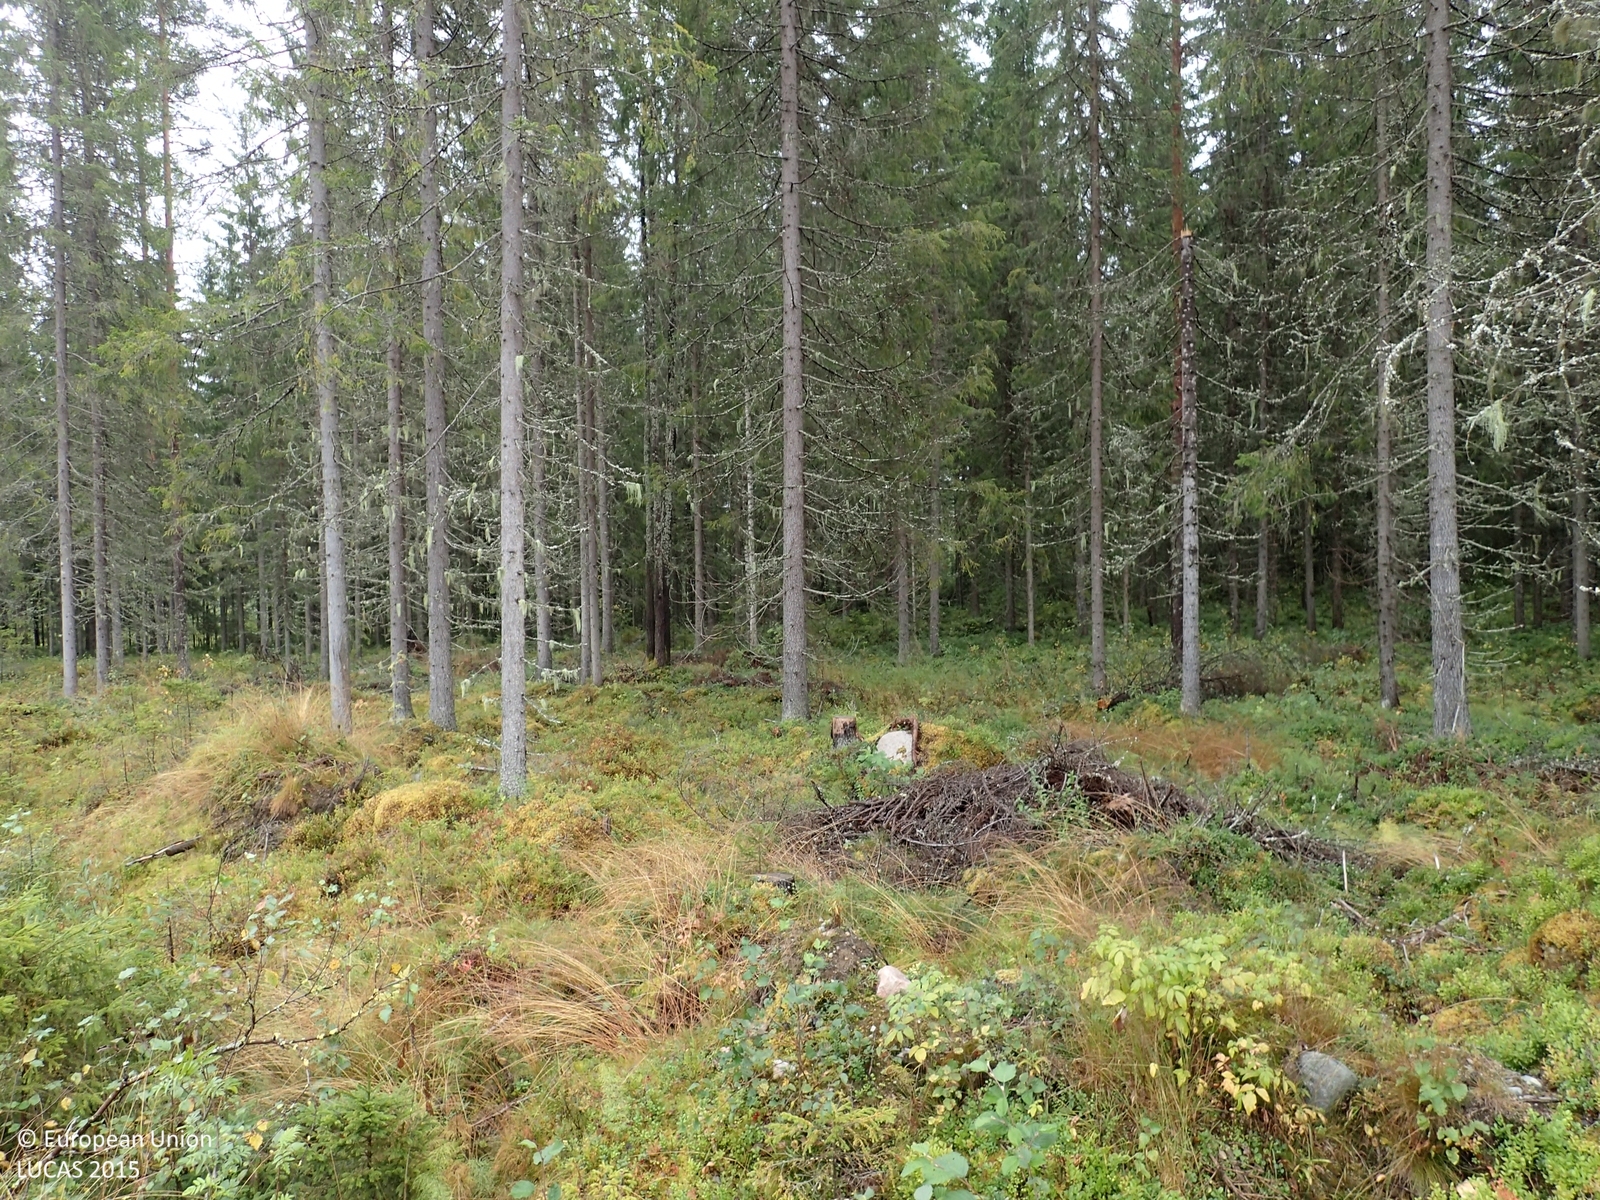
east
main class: Grassland
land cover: Grassland with sparse tree/shrub cover
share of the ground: > 75 %
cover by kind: herbaceous plants 85 %, broadleaved forest trees 5 %, shrubs 5 %, consolidated bare surface 5 %
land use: Forestry
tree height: < 5 m
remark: Clear cut
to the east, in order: Grassland with sparse tree/shrub cover; Ditches and canals; Spruce dominated coniferous woodland; Ditches and canals; Spruce dominated coniferous woodland; Ditches and canals; Spruce dominated coniferous woodland; Spruce dominated mixed woodland; Ditches and canals; Spruce dominated mixed woodland; Ditches and canals; Spruce dominated coniferous woodland
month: September
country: FI
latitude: 63.1970
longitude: 25.7545
